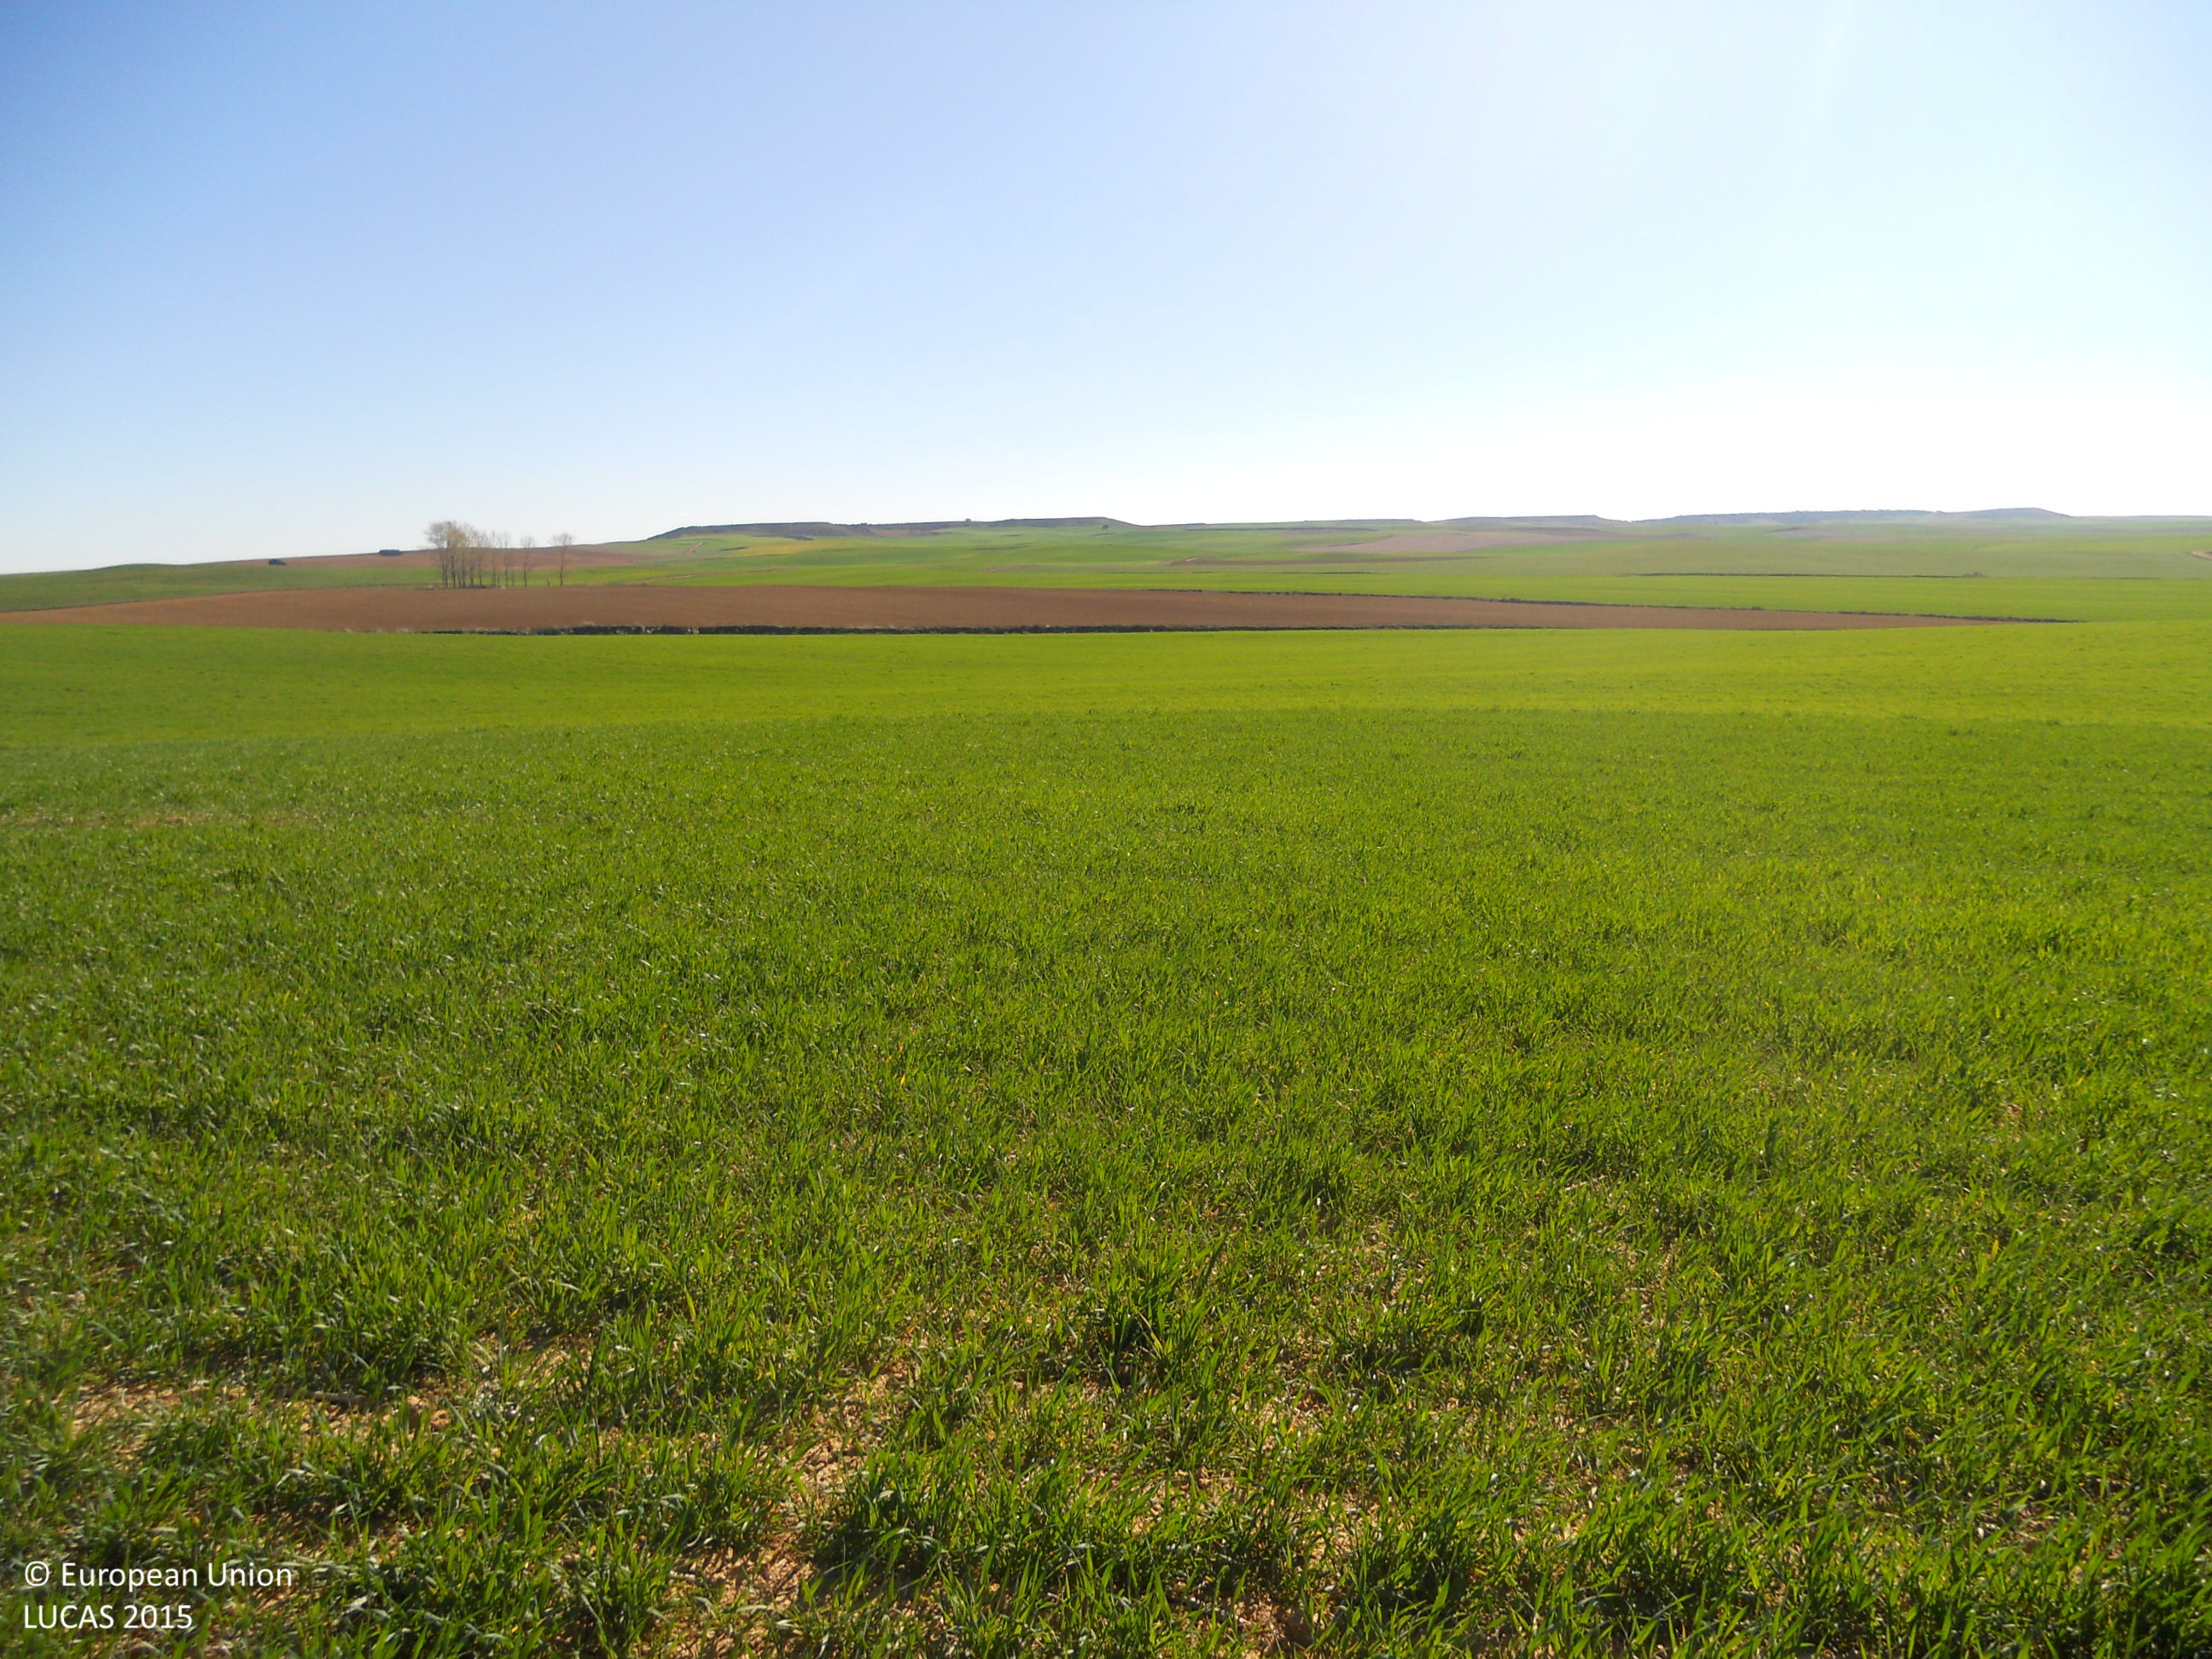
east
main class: Cropland
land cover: Barley
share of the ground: > 75 %
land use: Agriculture (excluding fallow land and kitchen gardens)
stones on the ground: < 10 %
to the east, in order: Barley; Grass margins; Sunflower
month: April
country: ES
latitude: 42.2096
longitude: -4.7447
